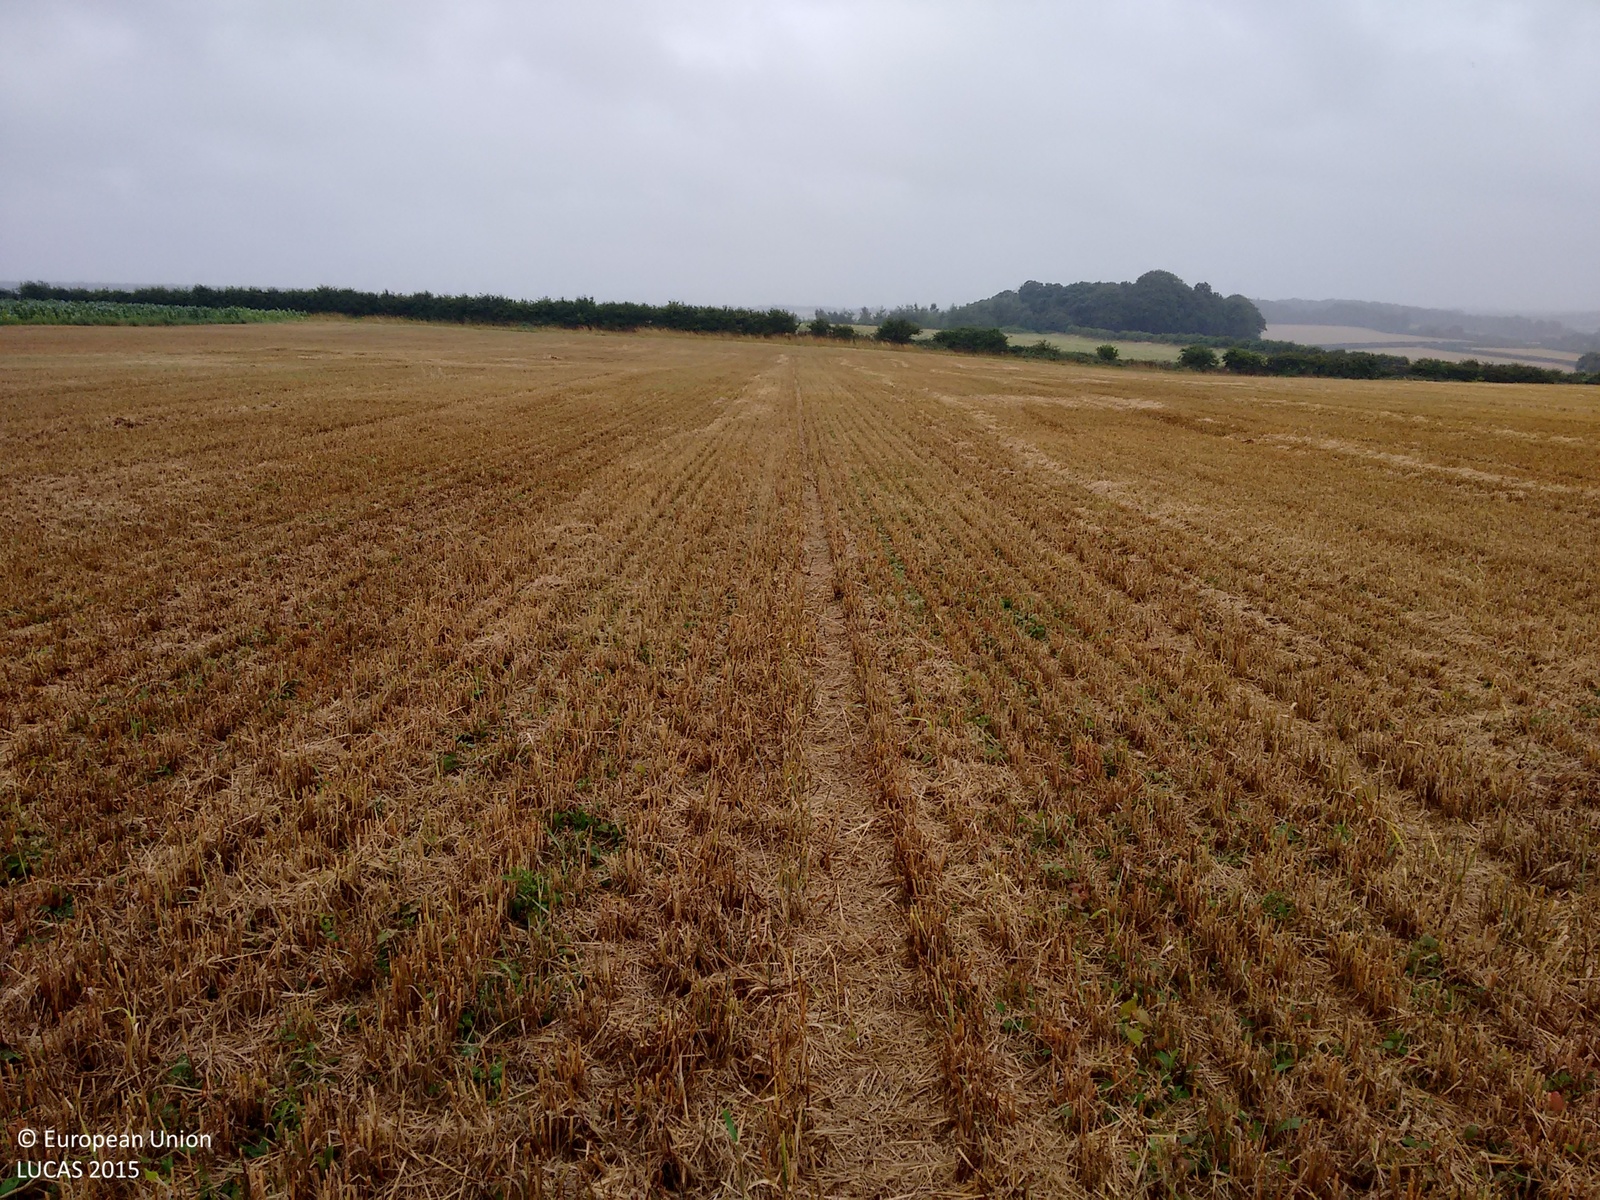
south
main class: Cropland
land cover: Common wheat
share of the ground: > 75 %
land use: Agriculture (excluding fallow land and kitchen gardens)
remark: Harvested field
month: August
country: GB
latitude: 52.9220
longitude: 0.7684
